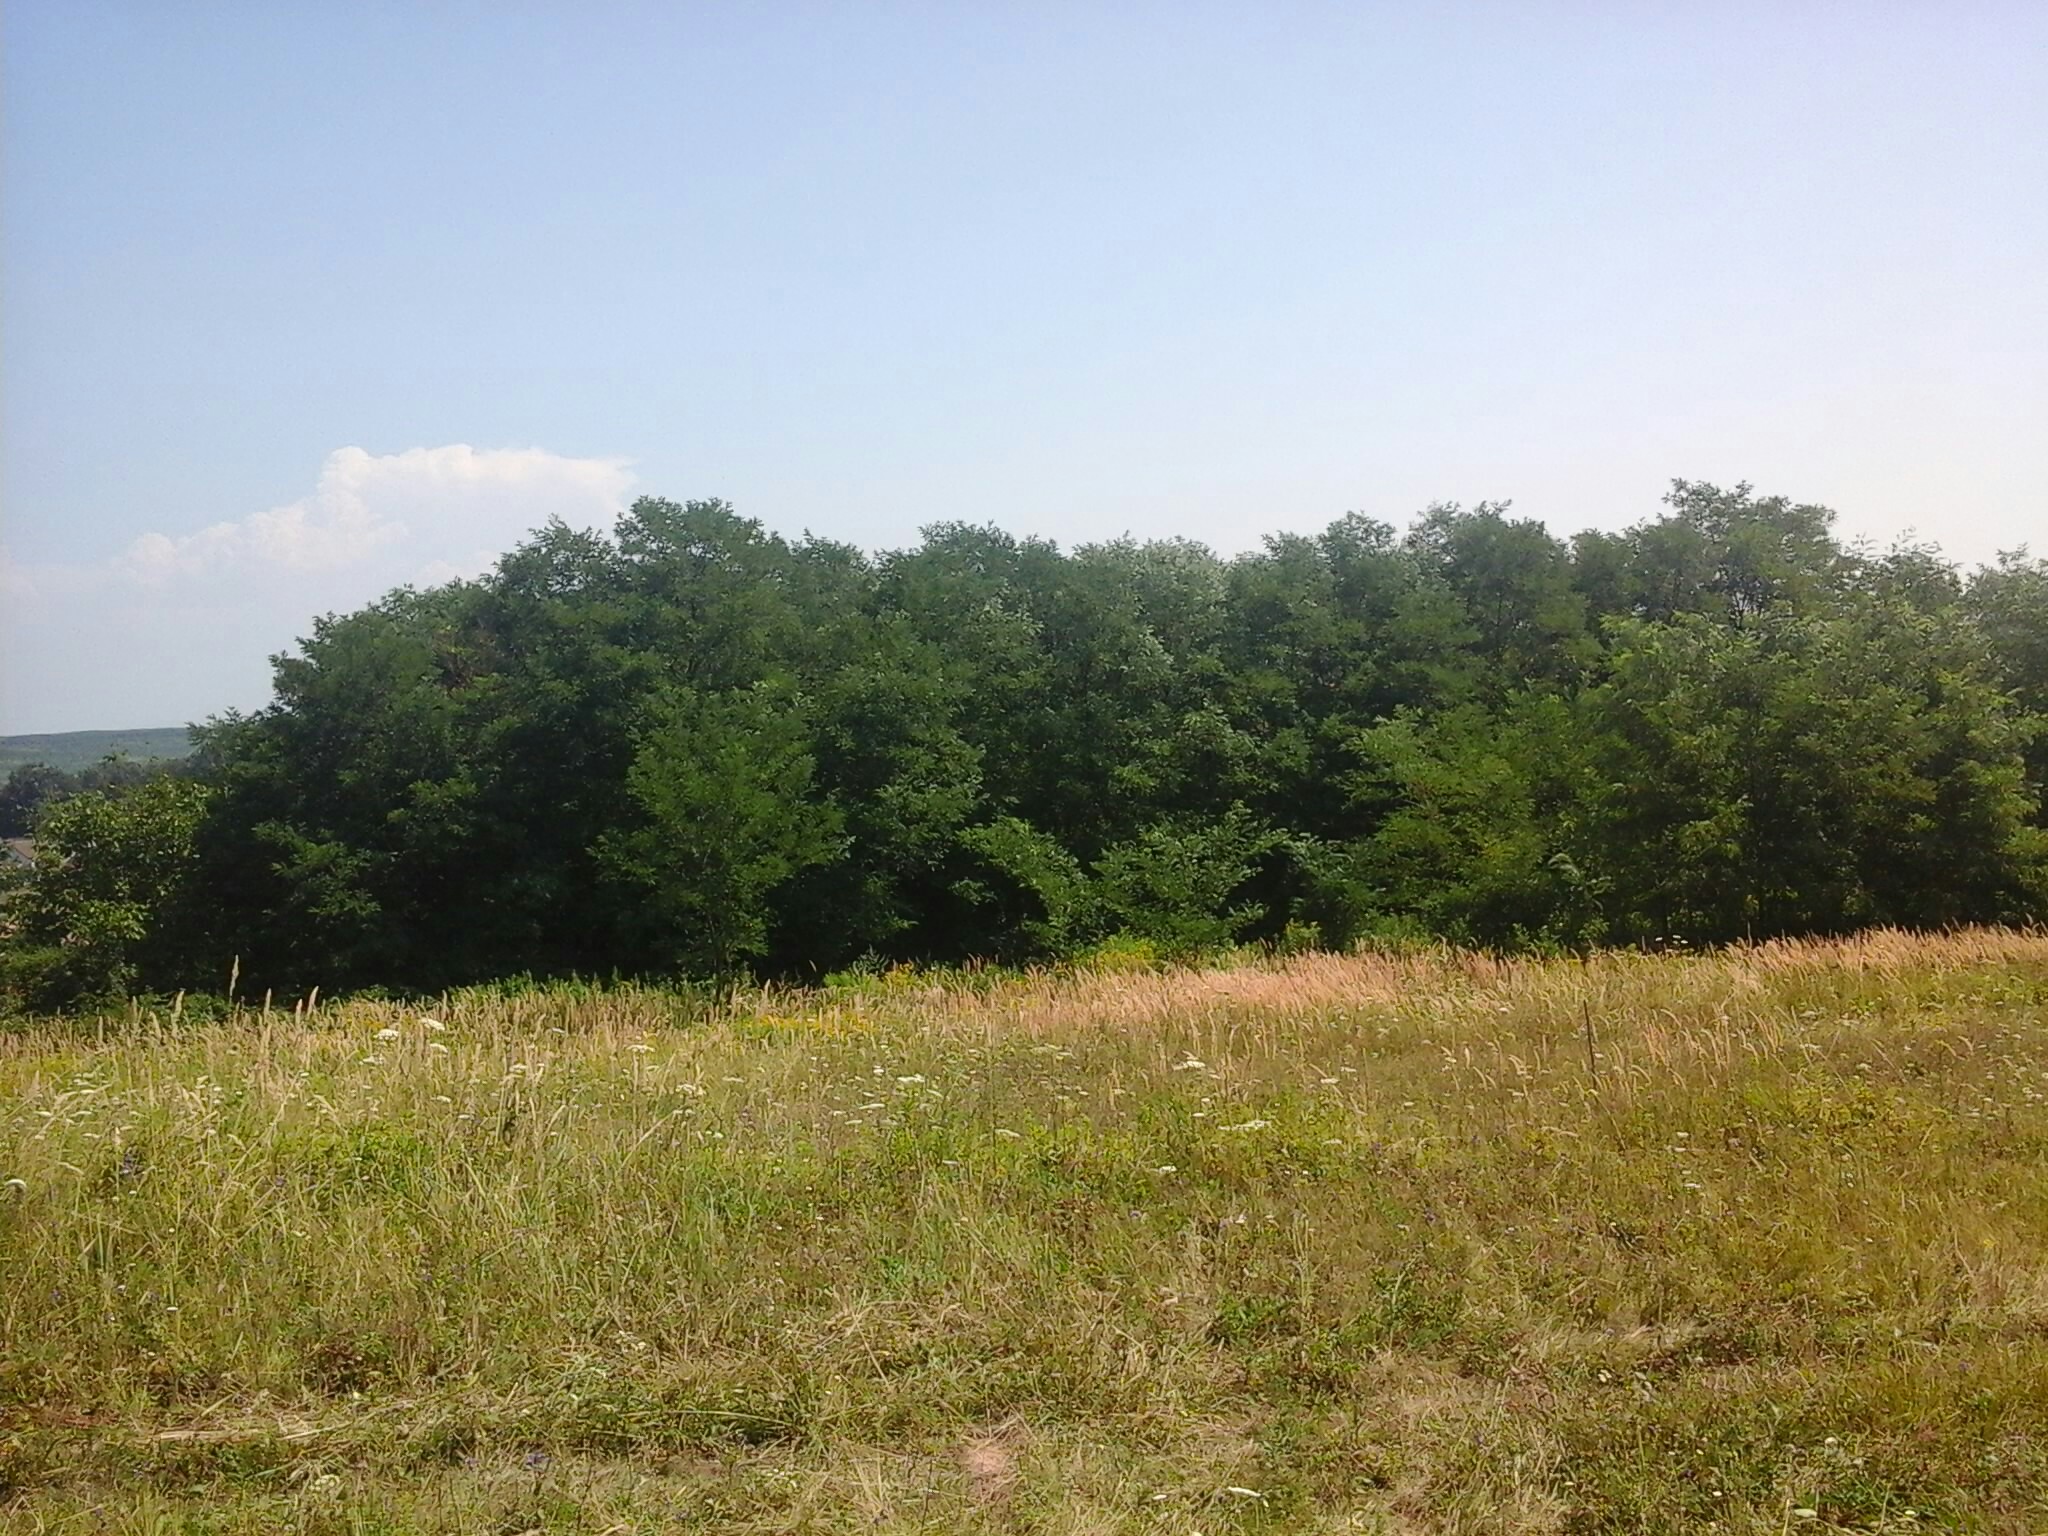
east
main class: Grassland
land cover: Grassland with sparse tree/shrub cover
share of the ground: > 75 %
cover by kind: herbaceous plants 85 %, shrubs 10 %, broadleaved forest trees 5 %
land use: Fallow land
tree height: > 5 m
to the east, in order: Grassland with sparse tree/shrub cover; Grassland without tree/shrub cover; Fences; Broadleaved woodland; Other fresh vegetables; Artificial constructions in urban areas
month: August
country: HU
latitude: 47.4080
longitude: 18.0015
